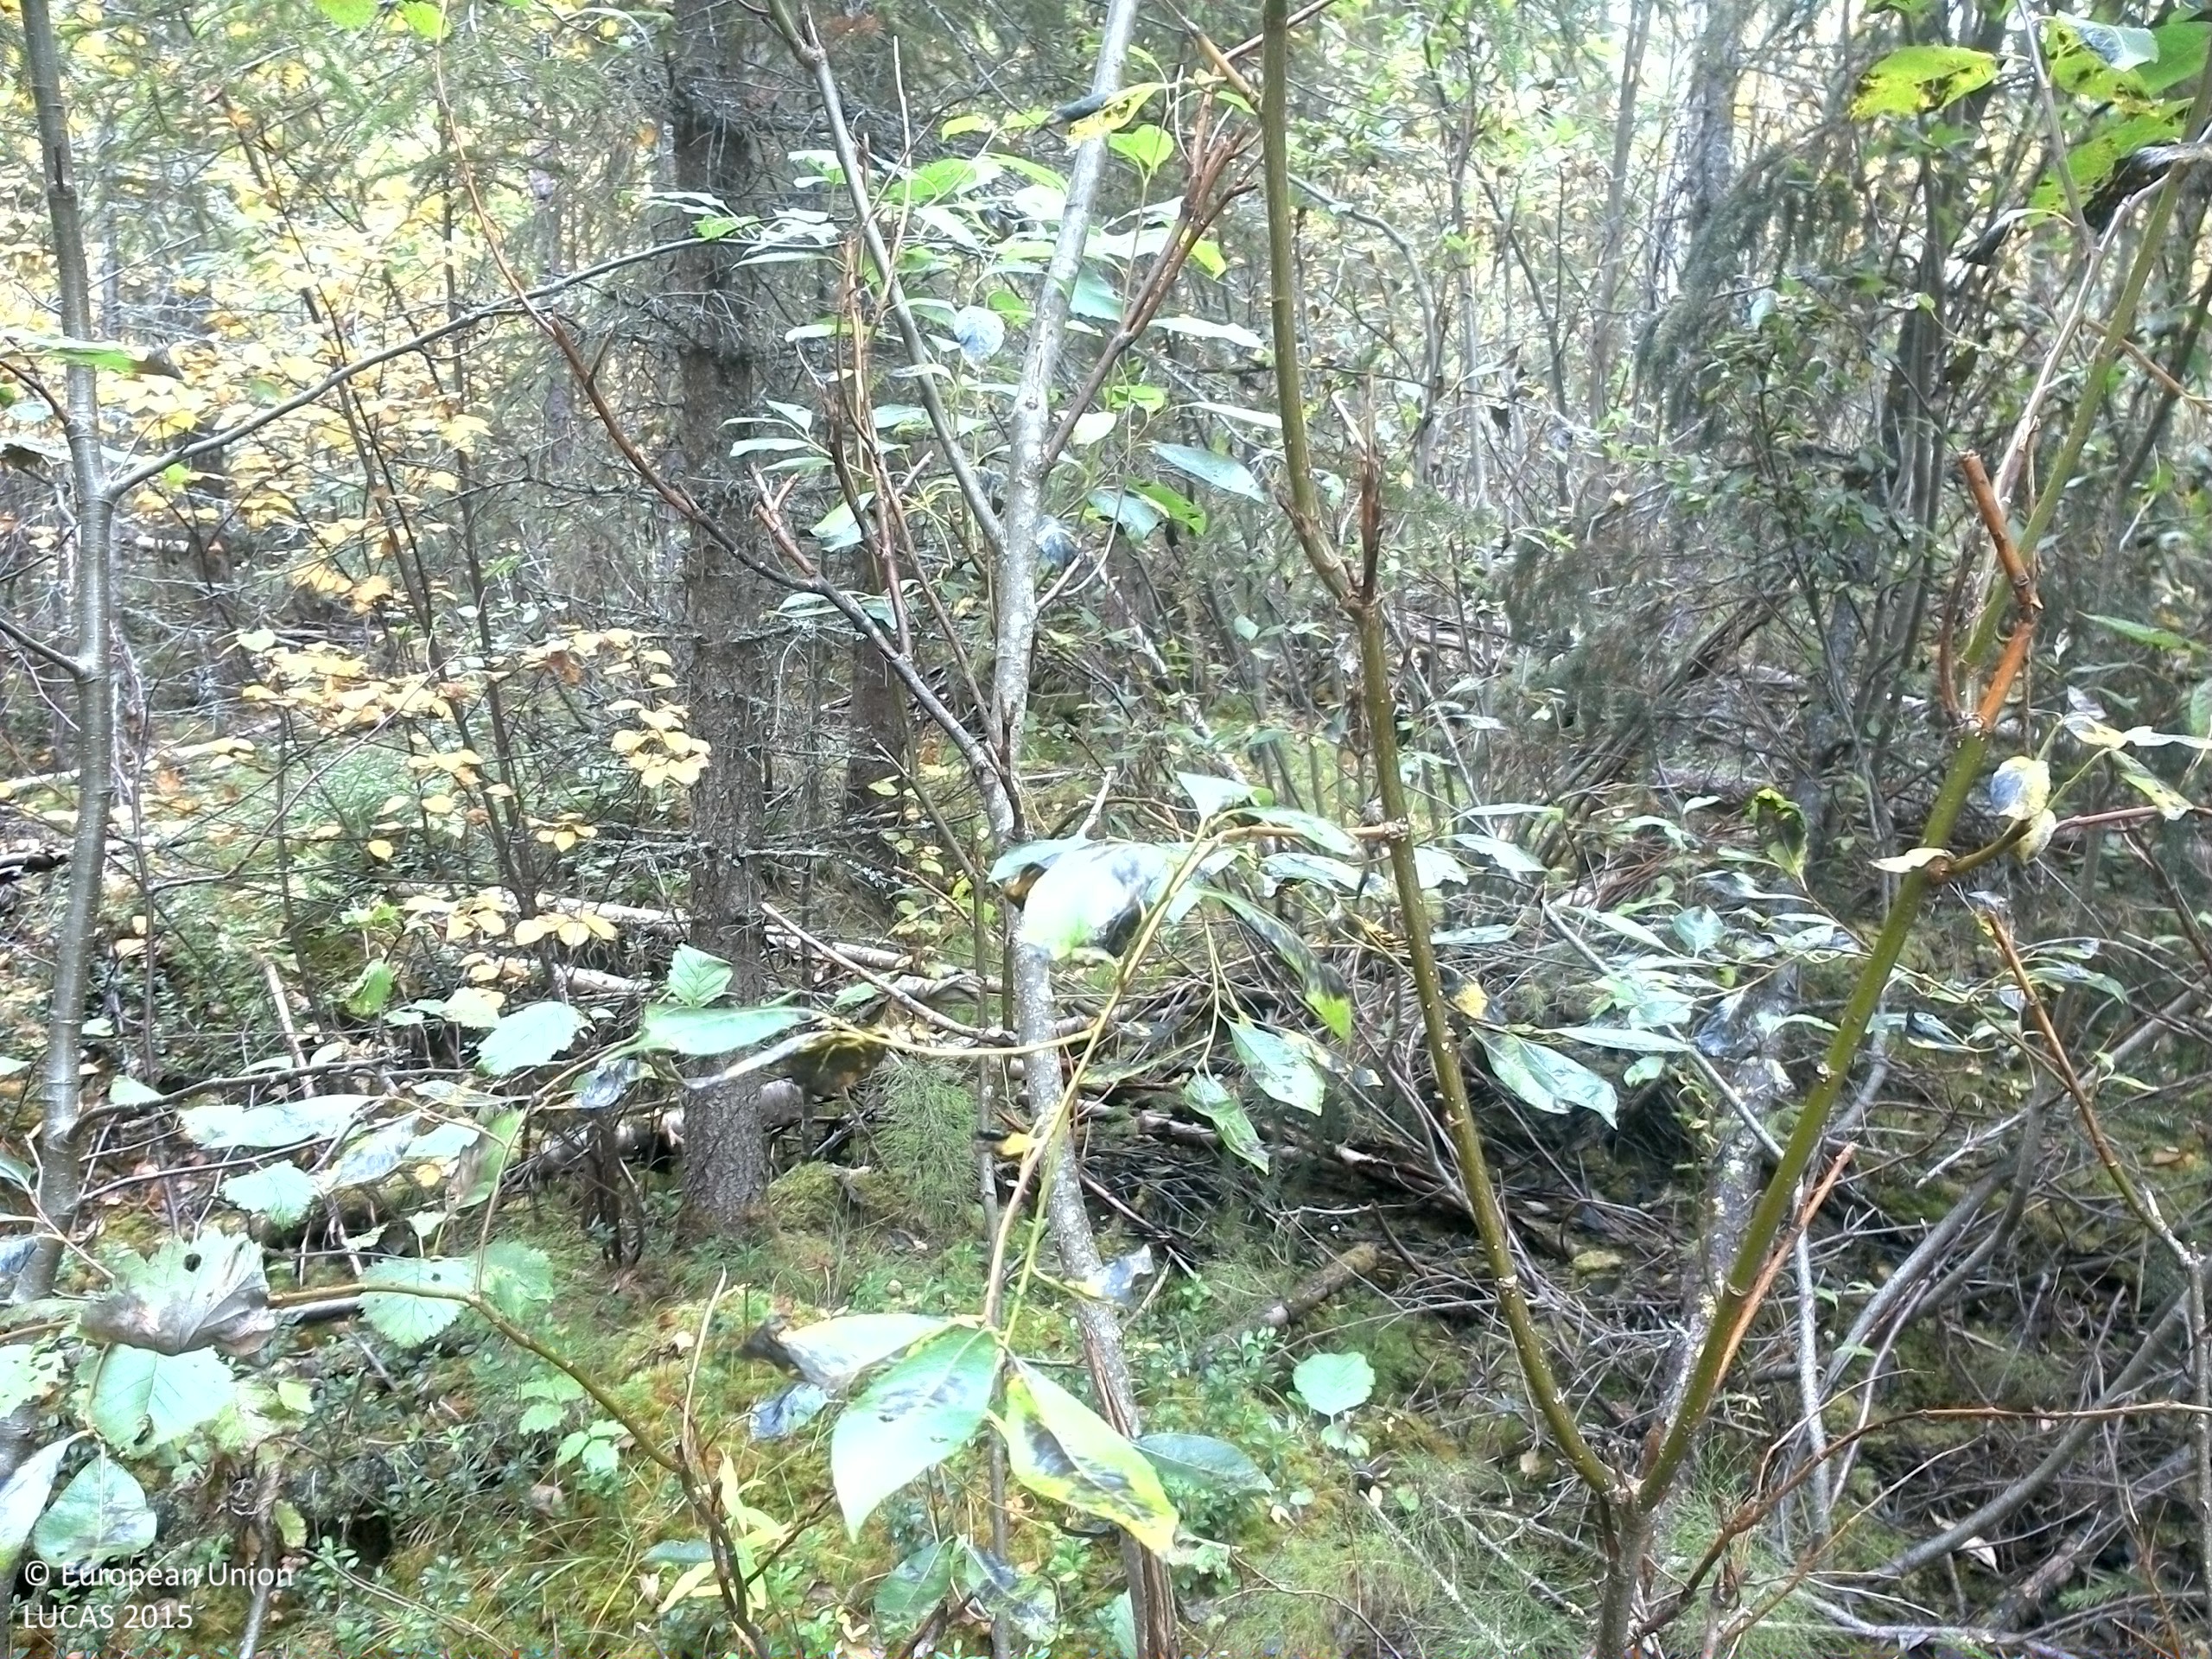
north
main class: Woodland
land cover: Spruce dominated mixed woodland
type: boreal forest
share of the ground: > 75 %
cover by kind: coniferous forest trees 45 %, broadleaved forest trees 30 %, shrubs 10 %, lichens and mosses 10 %, herbaceous plants 5 %
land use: Forestry
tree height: > 5 m
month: September
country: SE
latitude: 63.7324
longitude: 16.2307
